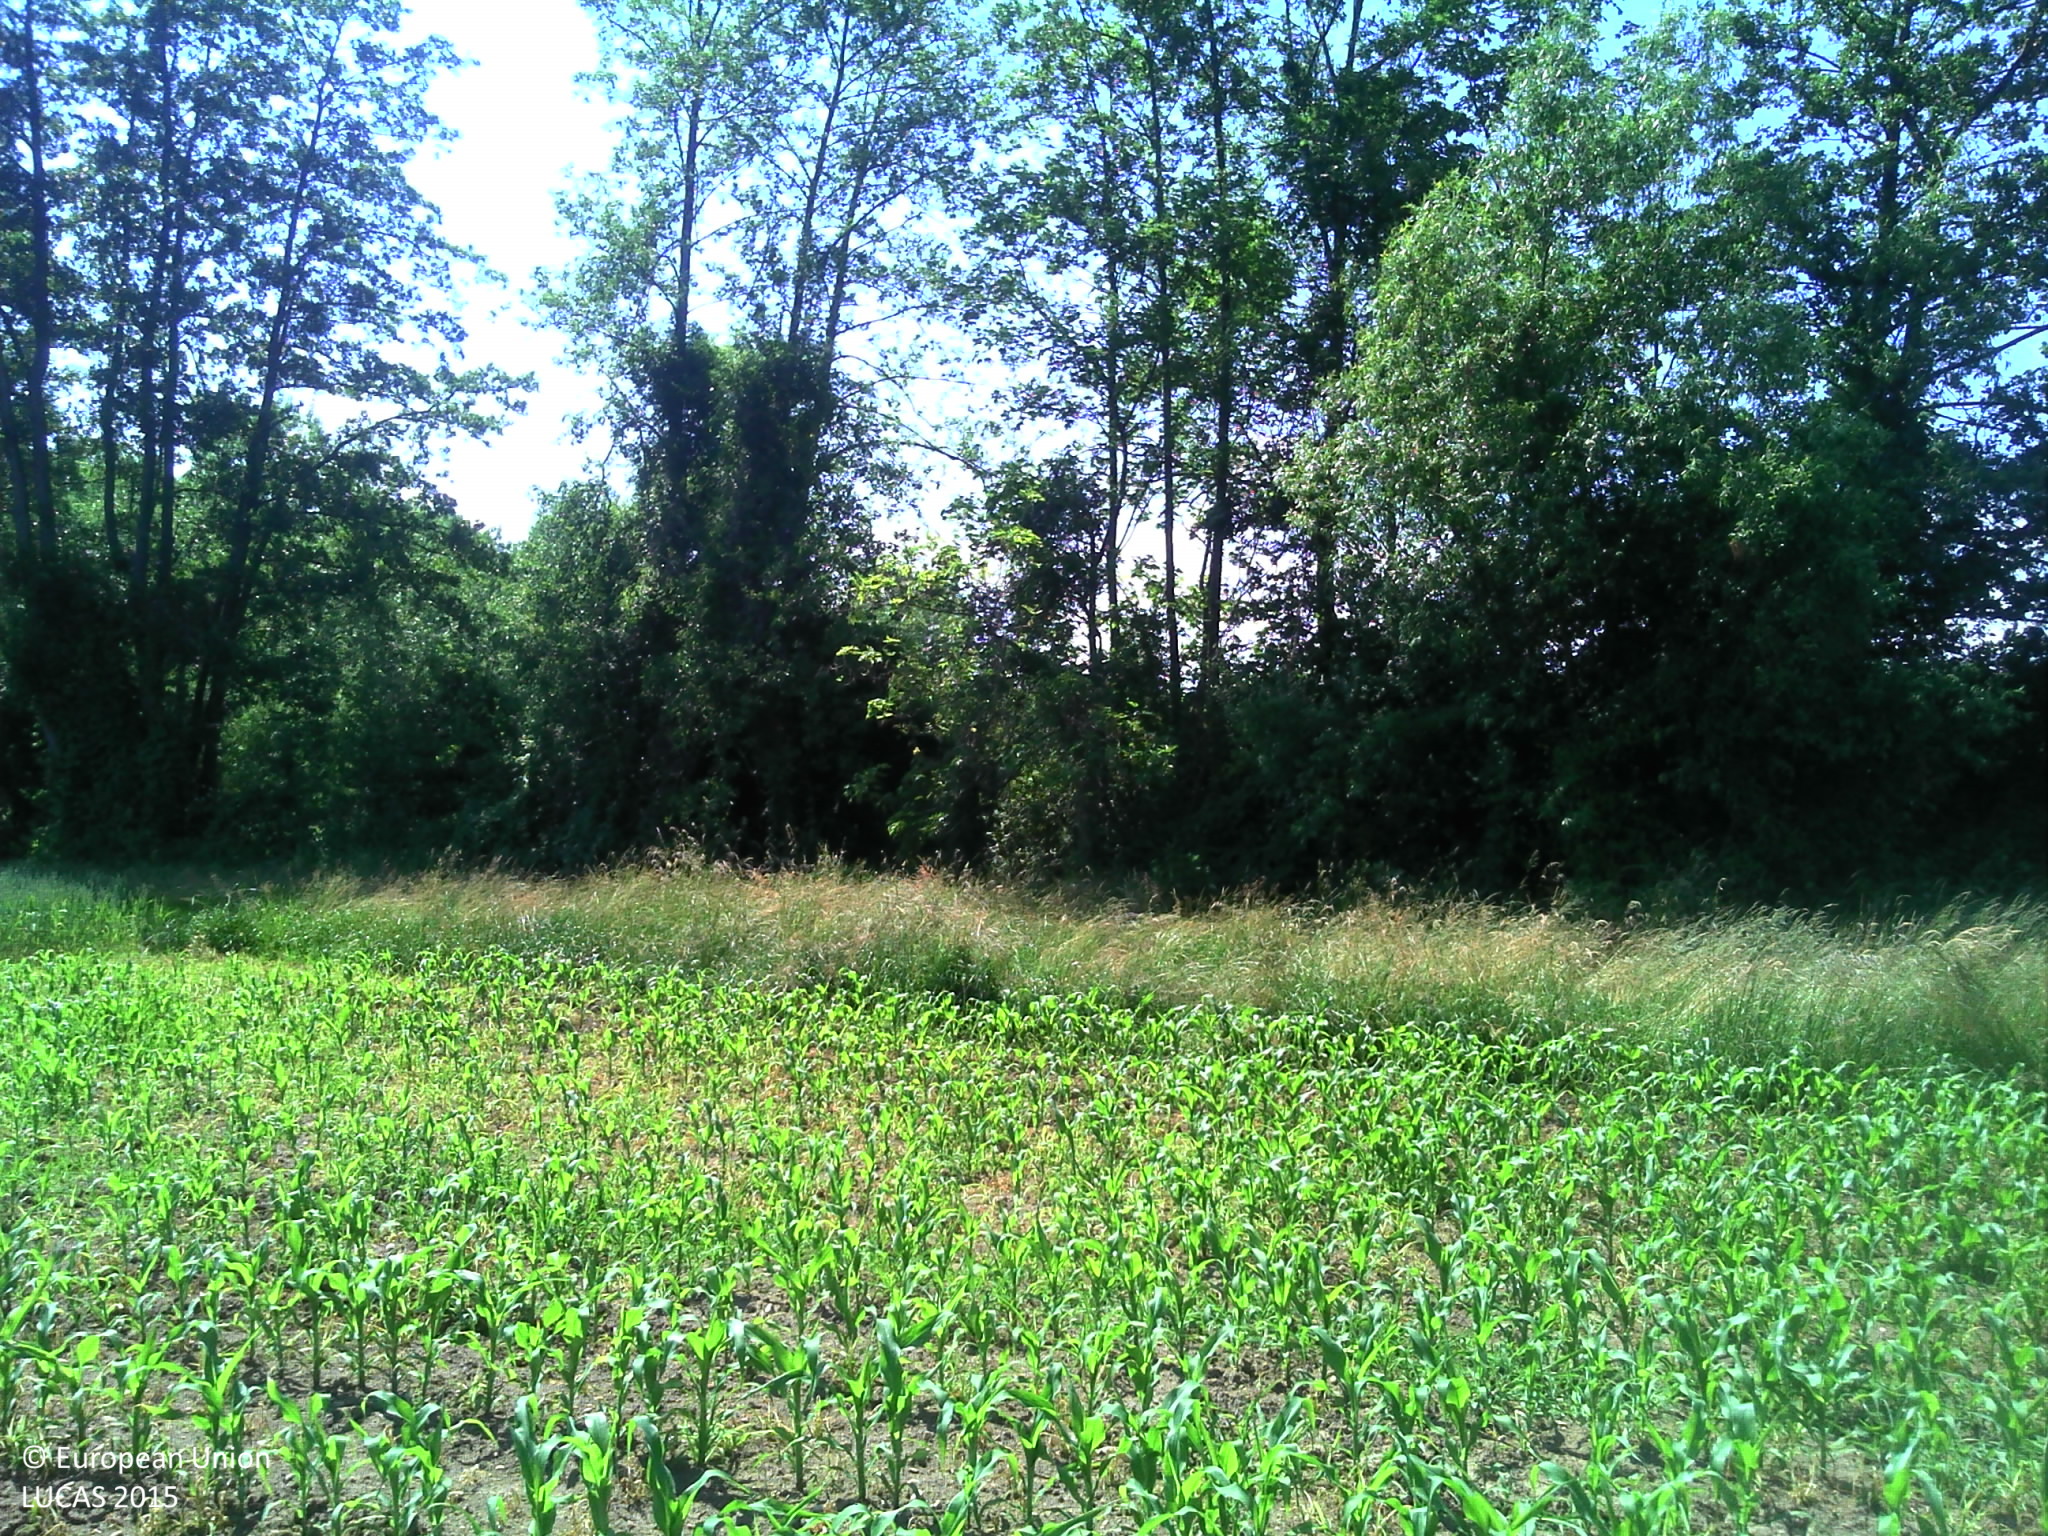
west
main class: Cropland
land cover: Maize
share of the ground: 10 - 25 %
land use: Agriculture (excluding fallow land and kitchen gardens)
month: June
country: FR
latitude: 48.4496
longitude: 7.6078
